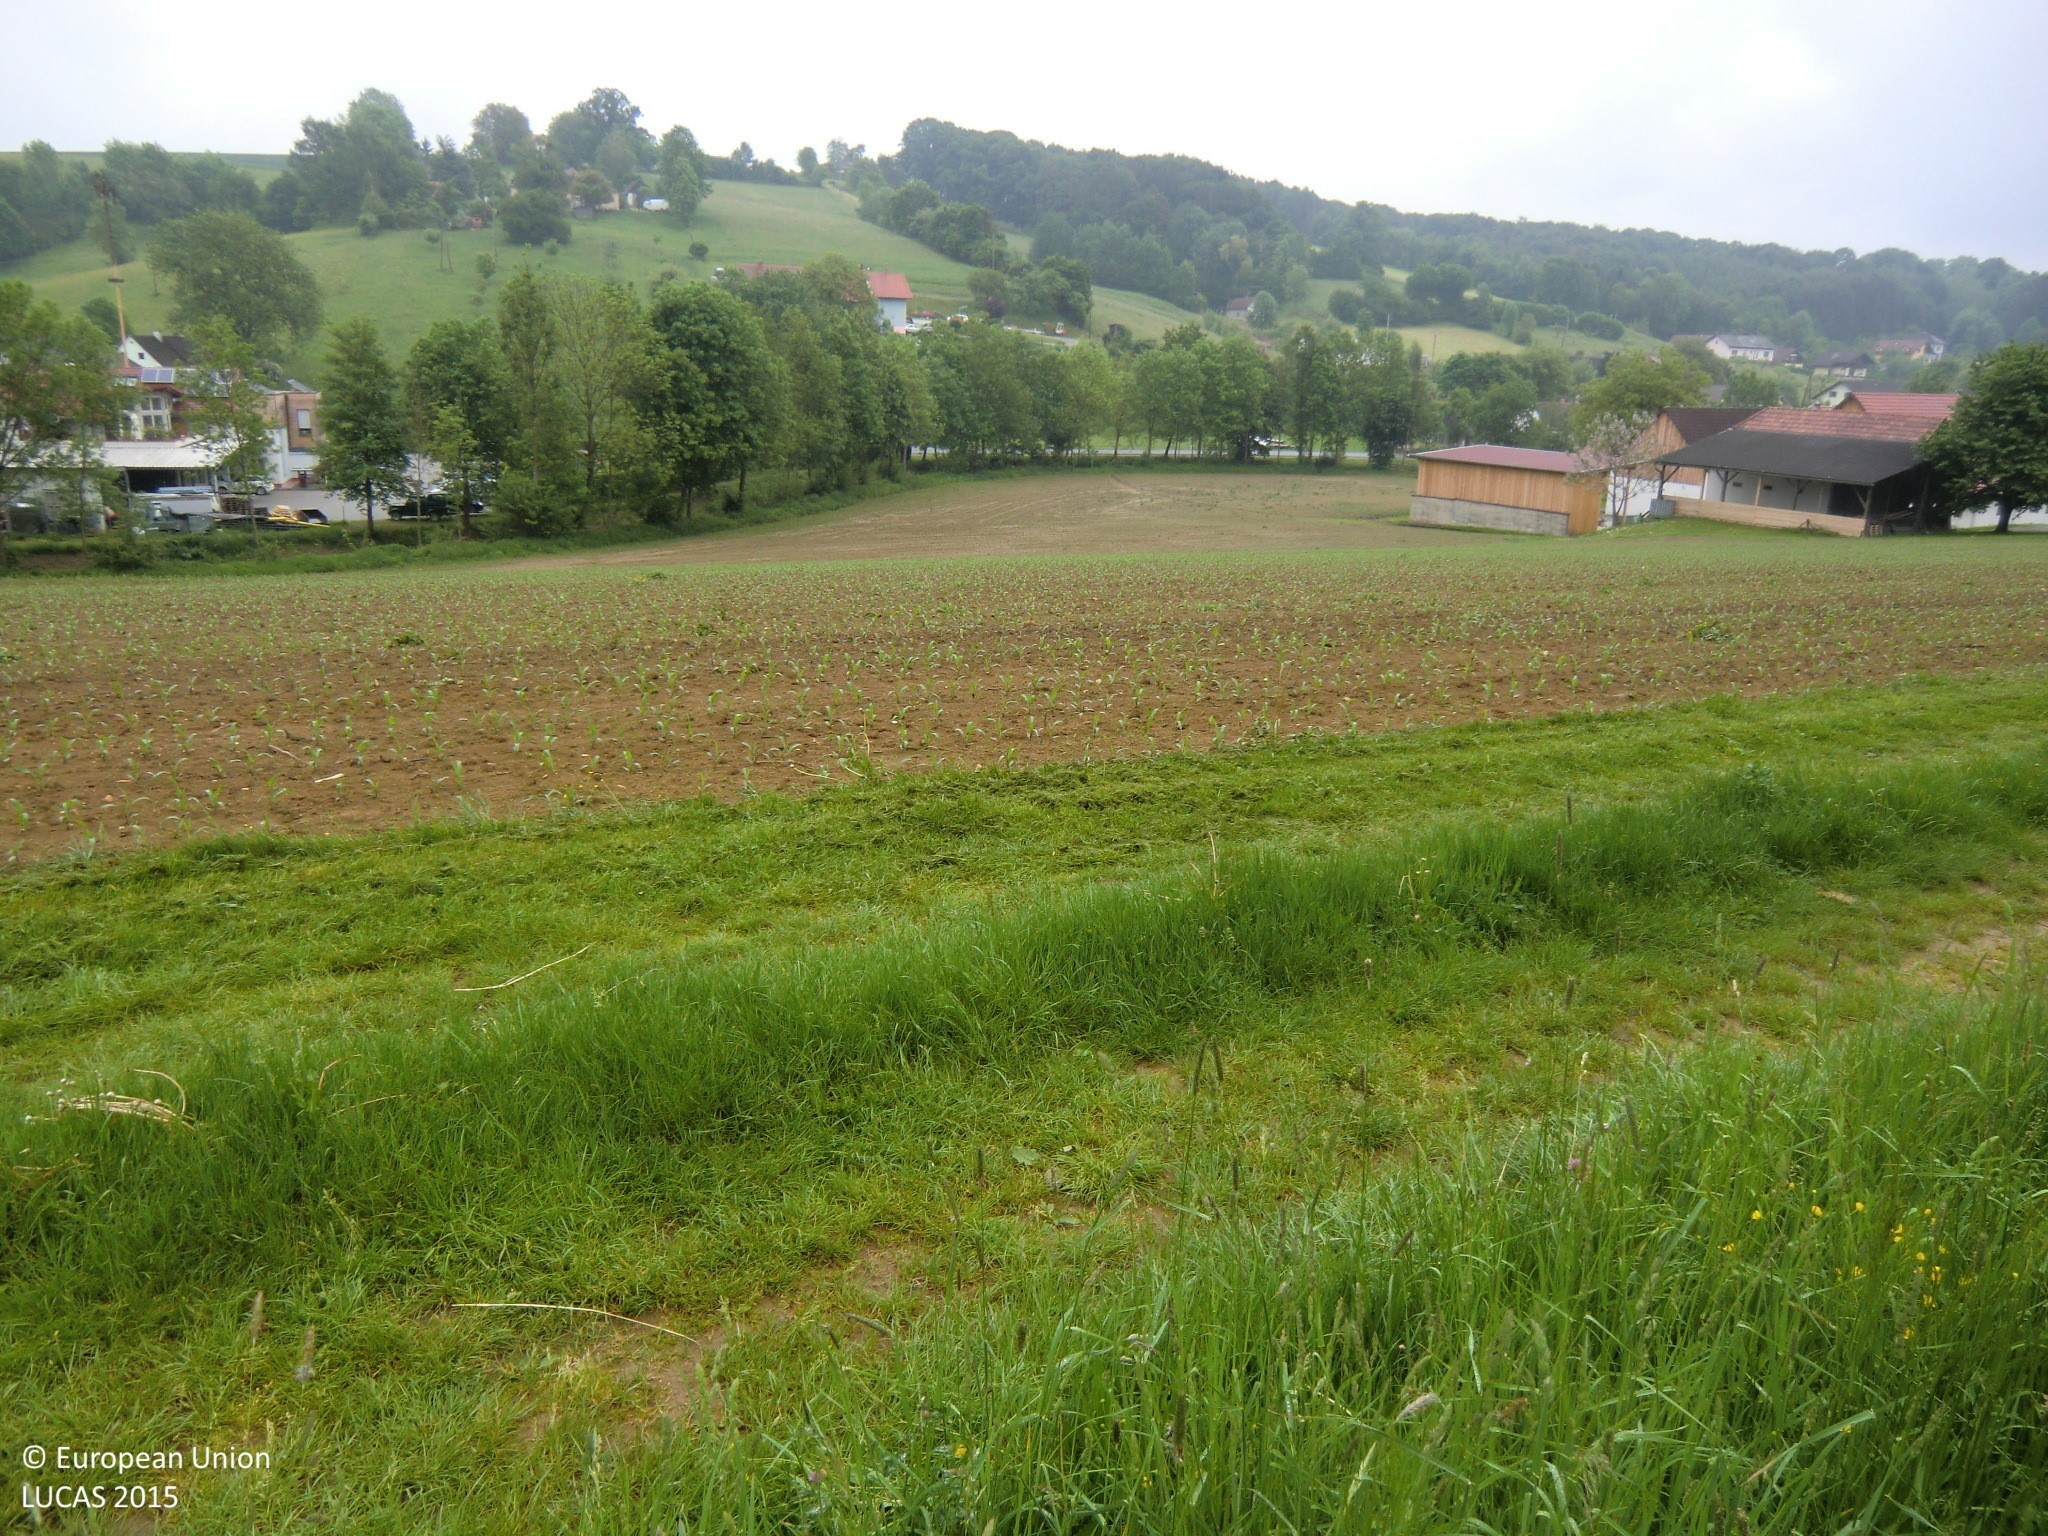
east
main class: Cropland
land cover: Apple fruit
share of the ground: 25 - 50 %
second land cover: Grassland without tree/shrub cover
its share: > 75 %
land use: Agriculture (excluding fallow land and kitchen gardens)
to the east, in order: Apple fruit; Grassland without tree/shrub cover; Tracks; Maize; Grass margins; Broadleaved woodland; Inland fresh running water; Grassland without tree/shrub cover; Artificial constructions in urban areas; Grass margins; Ditches and canals; Fences; Grassland without tree/shrub cover; Broadleaved woodland; Artificial constructions in urban areas
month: May
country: AT
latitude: 47.3190
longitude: 16.0215
